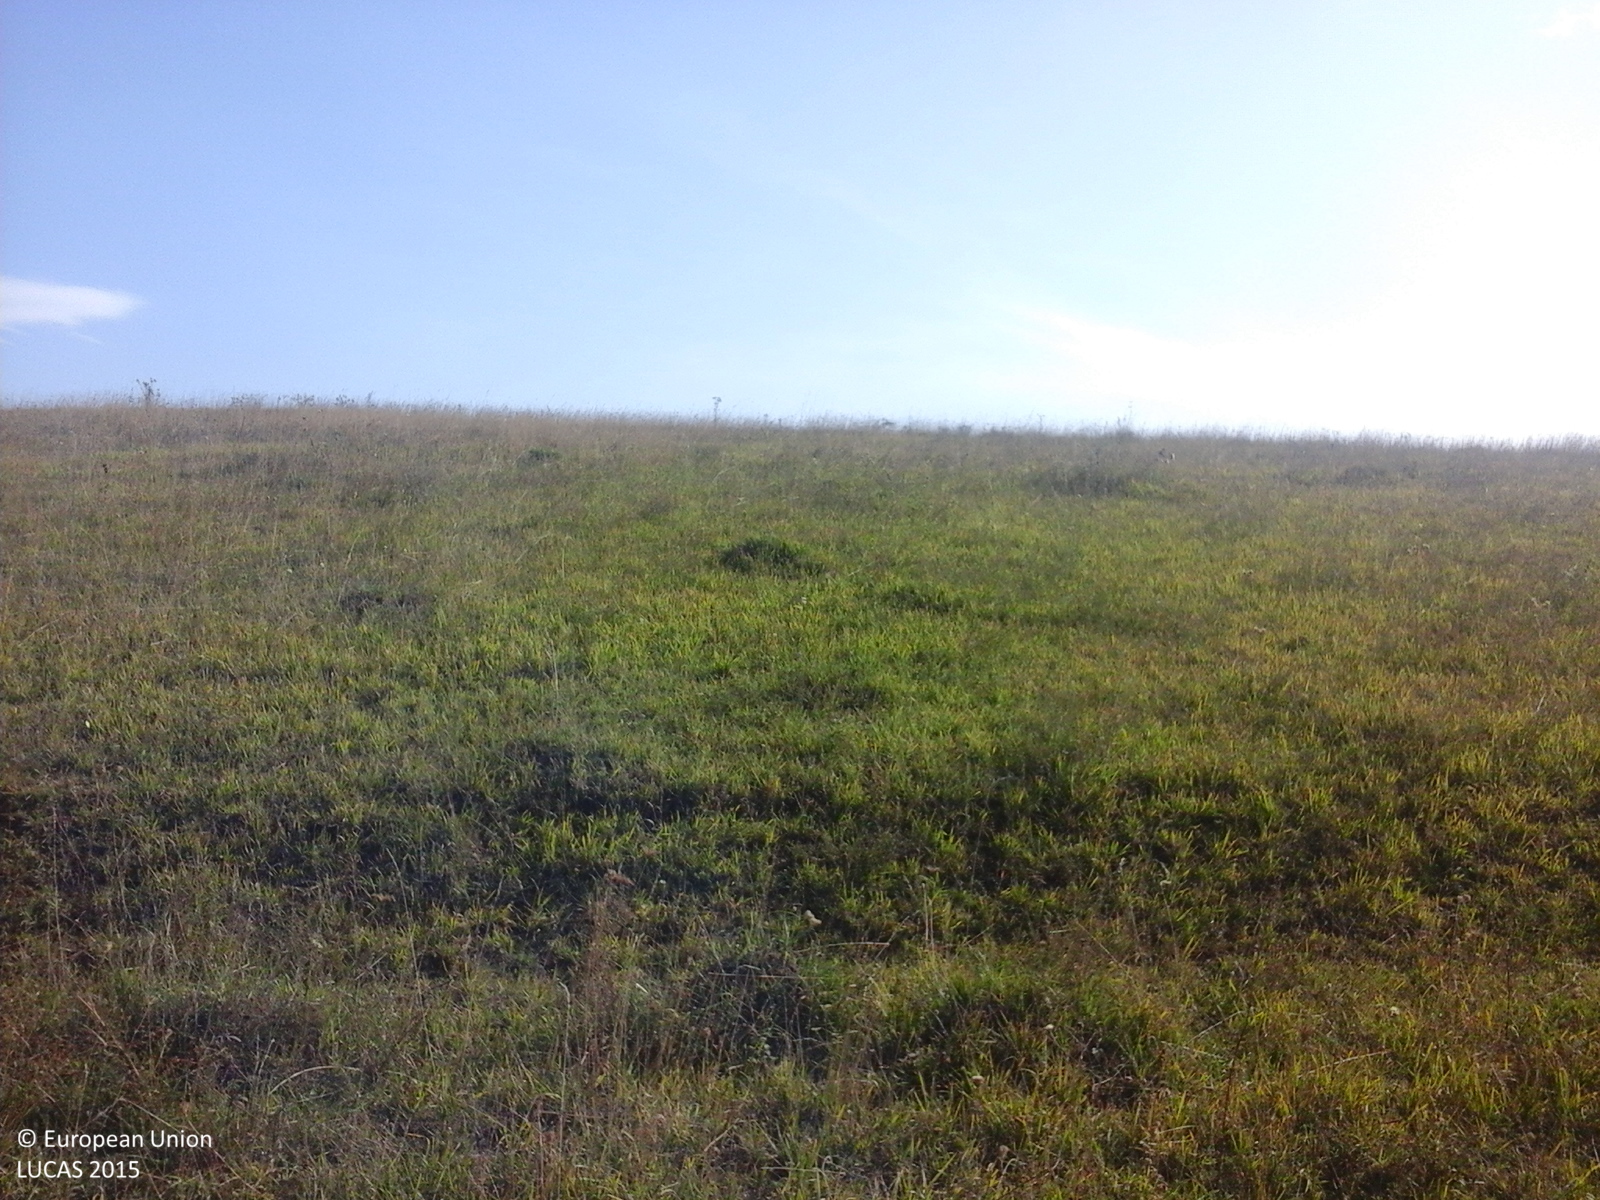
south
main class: Grassland
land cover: Grassland without tree/shrub cover
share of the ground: > 75 %
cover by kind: herbaceous plants 100 %
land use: Agriculture (excluding fallow land and kitchen gardens)
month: September
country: RO
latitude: 46.7919
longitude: 23.3108
